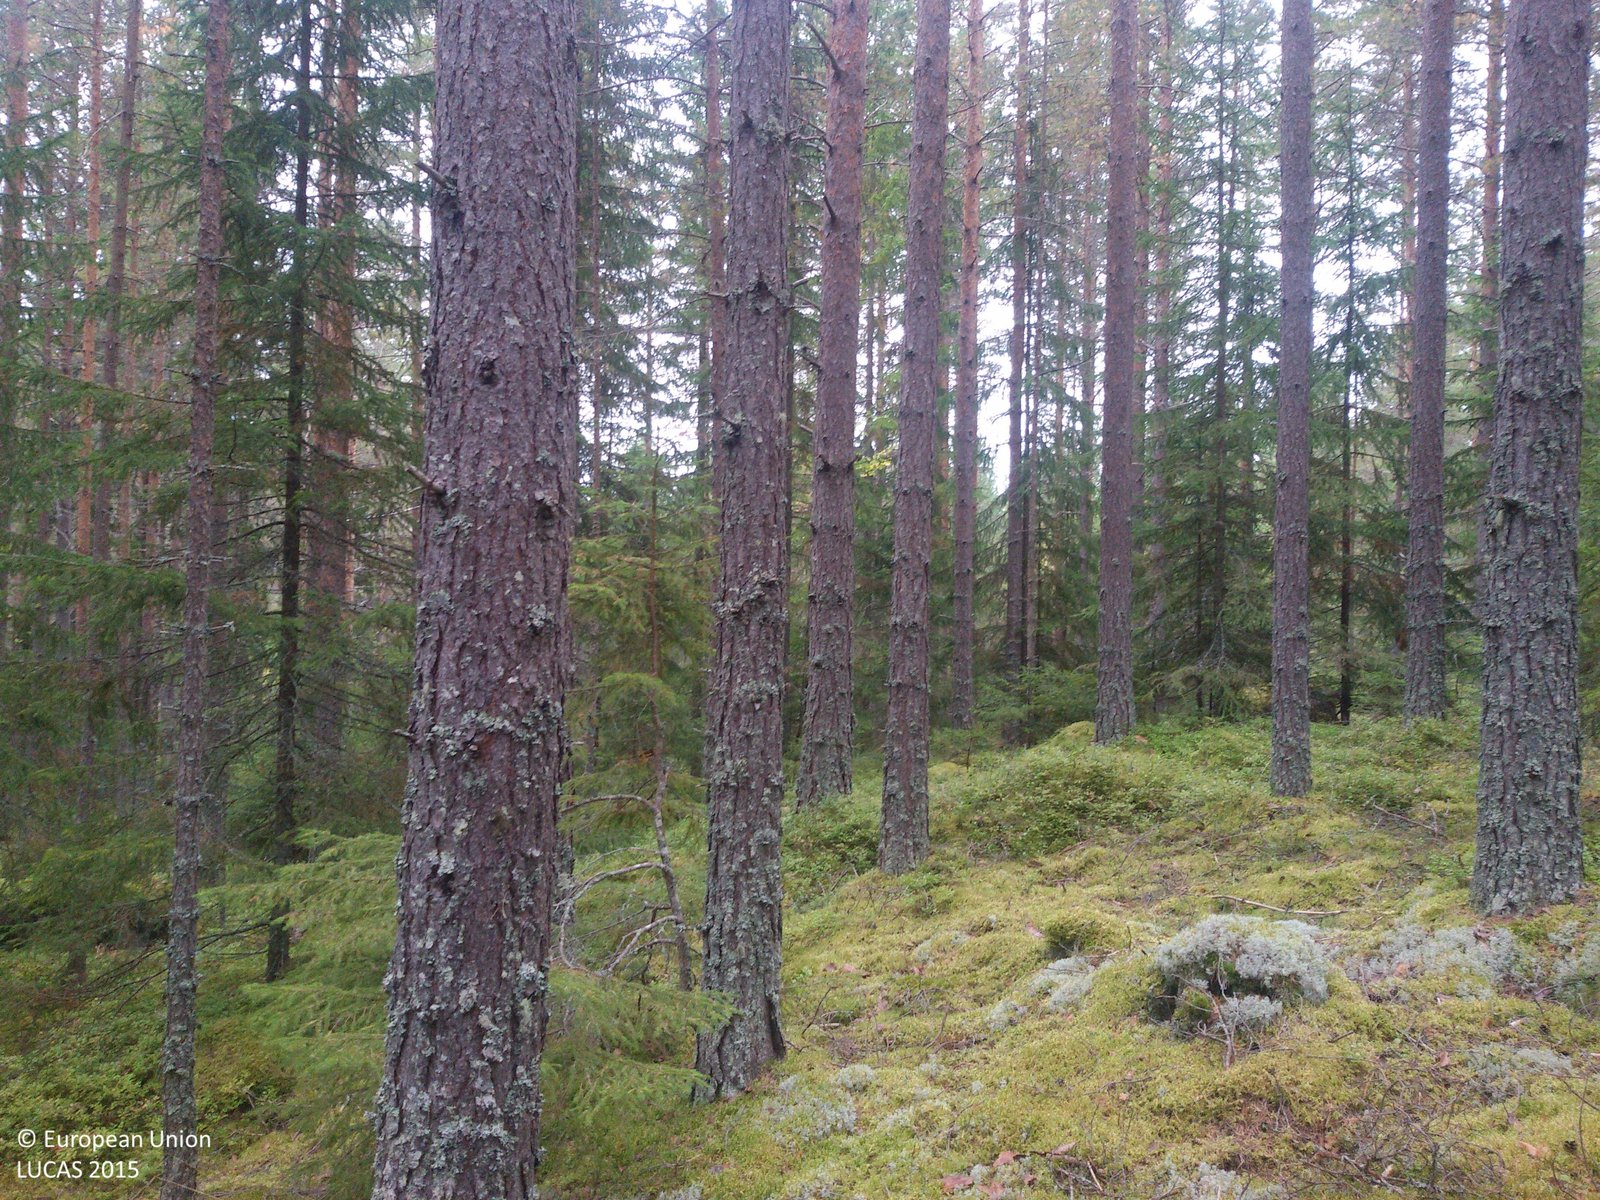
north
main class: Woodland
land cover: Pine dominated coniferous woodland
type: boreal forest
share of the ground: > 75 %
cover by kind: coniferous forest trees 75 %, shrubs 15 %, lichens and mosses 10 %
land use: Forestry
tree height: > 5 m
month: September
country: SE
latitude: 61.0709
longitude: 14.3047
